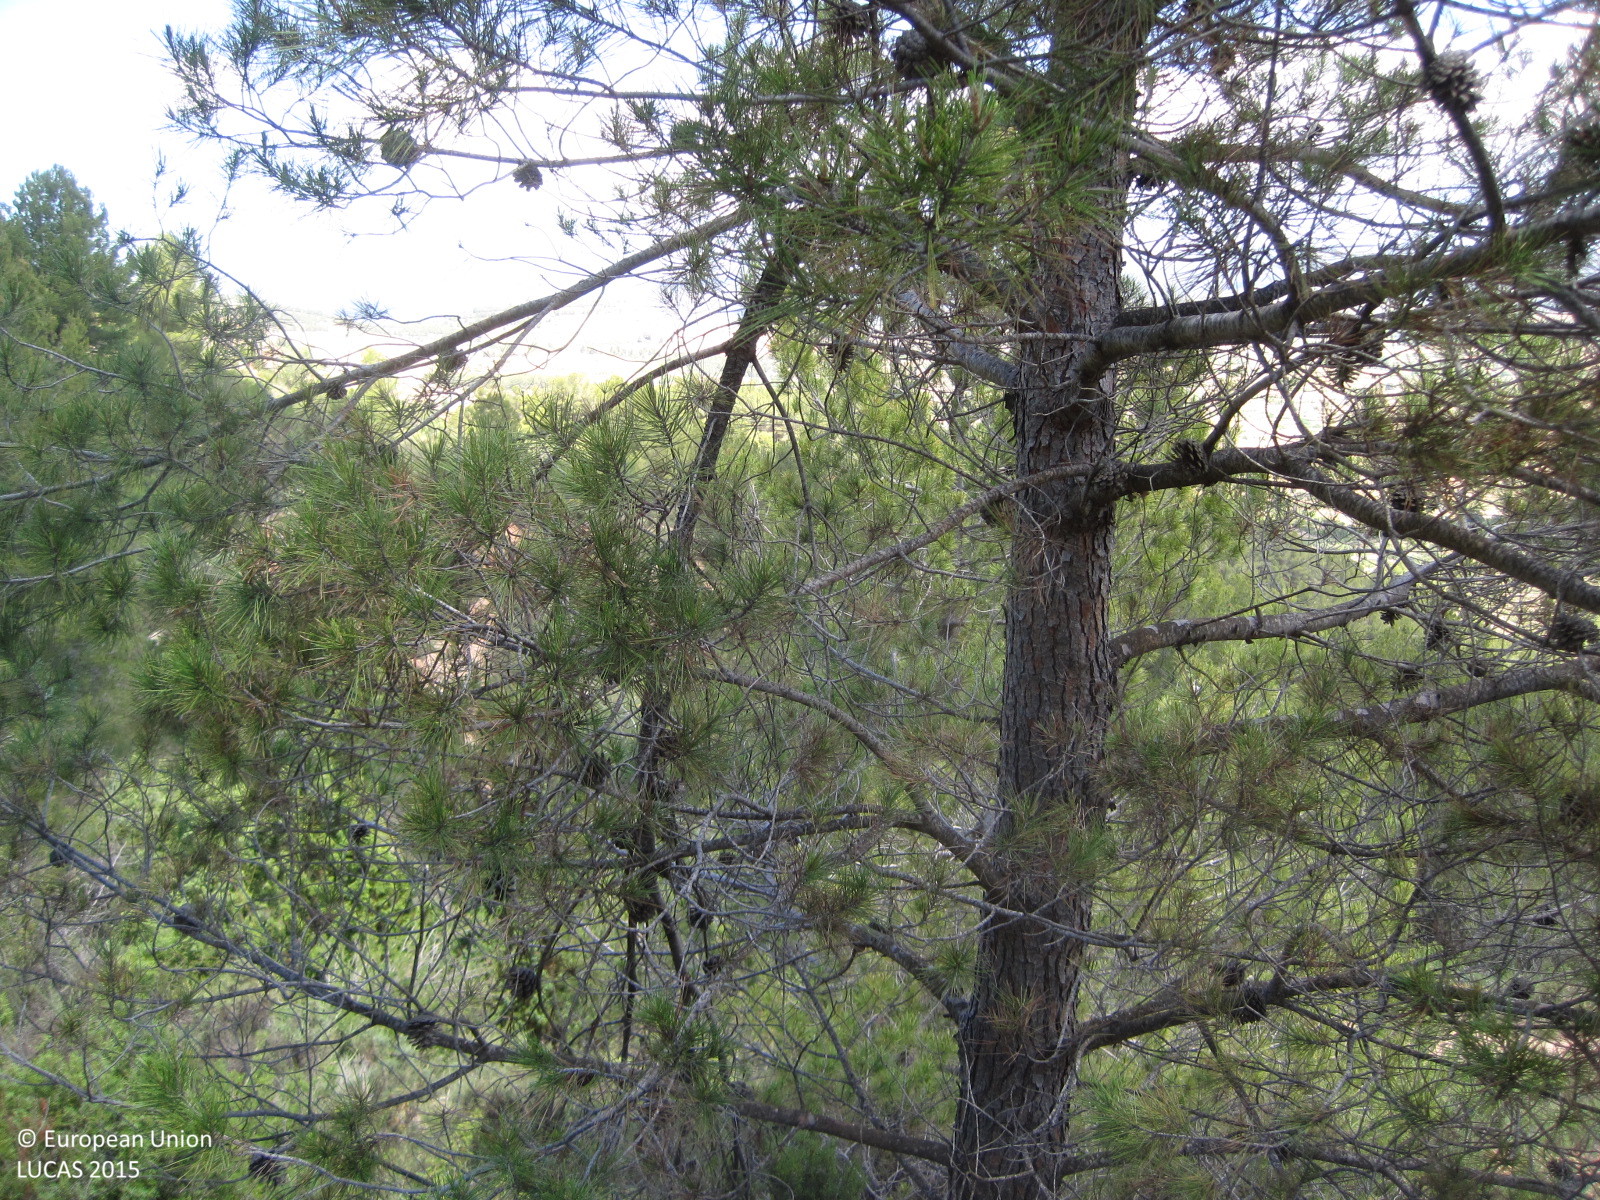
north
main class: Woodland
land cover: Broadleaved woodland
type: acidophilous oak and oak-birch forest
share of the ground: 10 - 25 %
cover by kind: broadleaved forest trees 30 %, shrubs 30 %, consolidated bare surface 25 %, herbaceous plants 10 %, coniferous forest trees 5 %
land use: Forestry
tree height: < 5 m
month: June
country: ES
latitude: 39.8678
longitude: -0.9824
